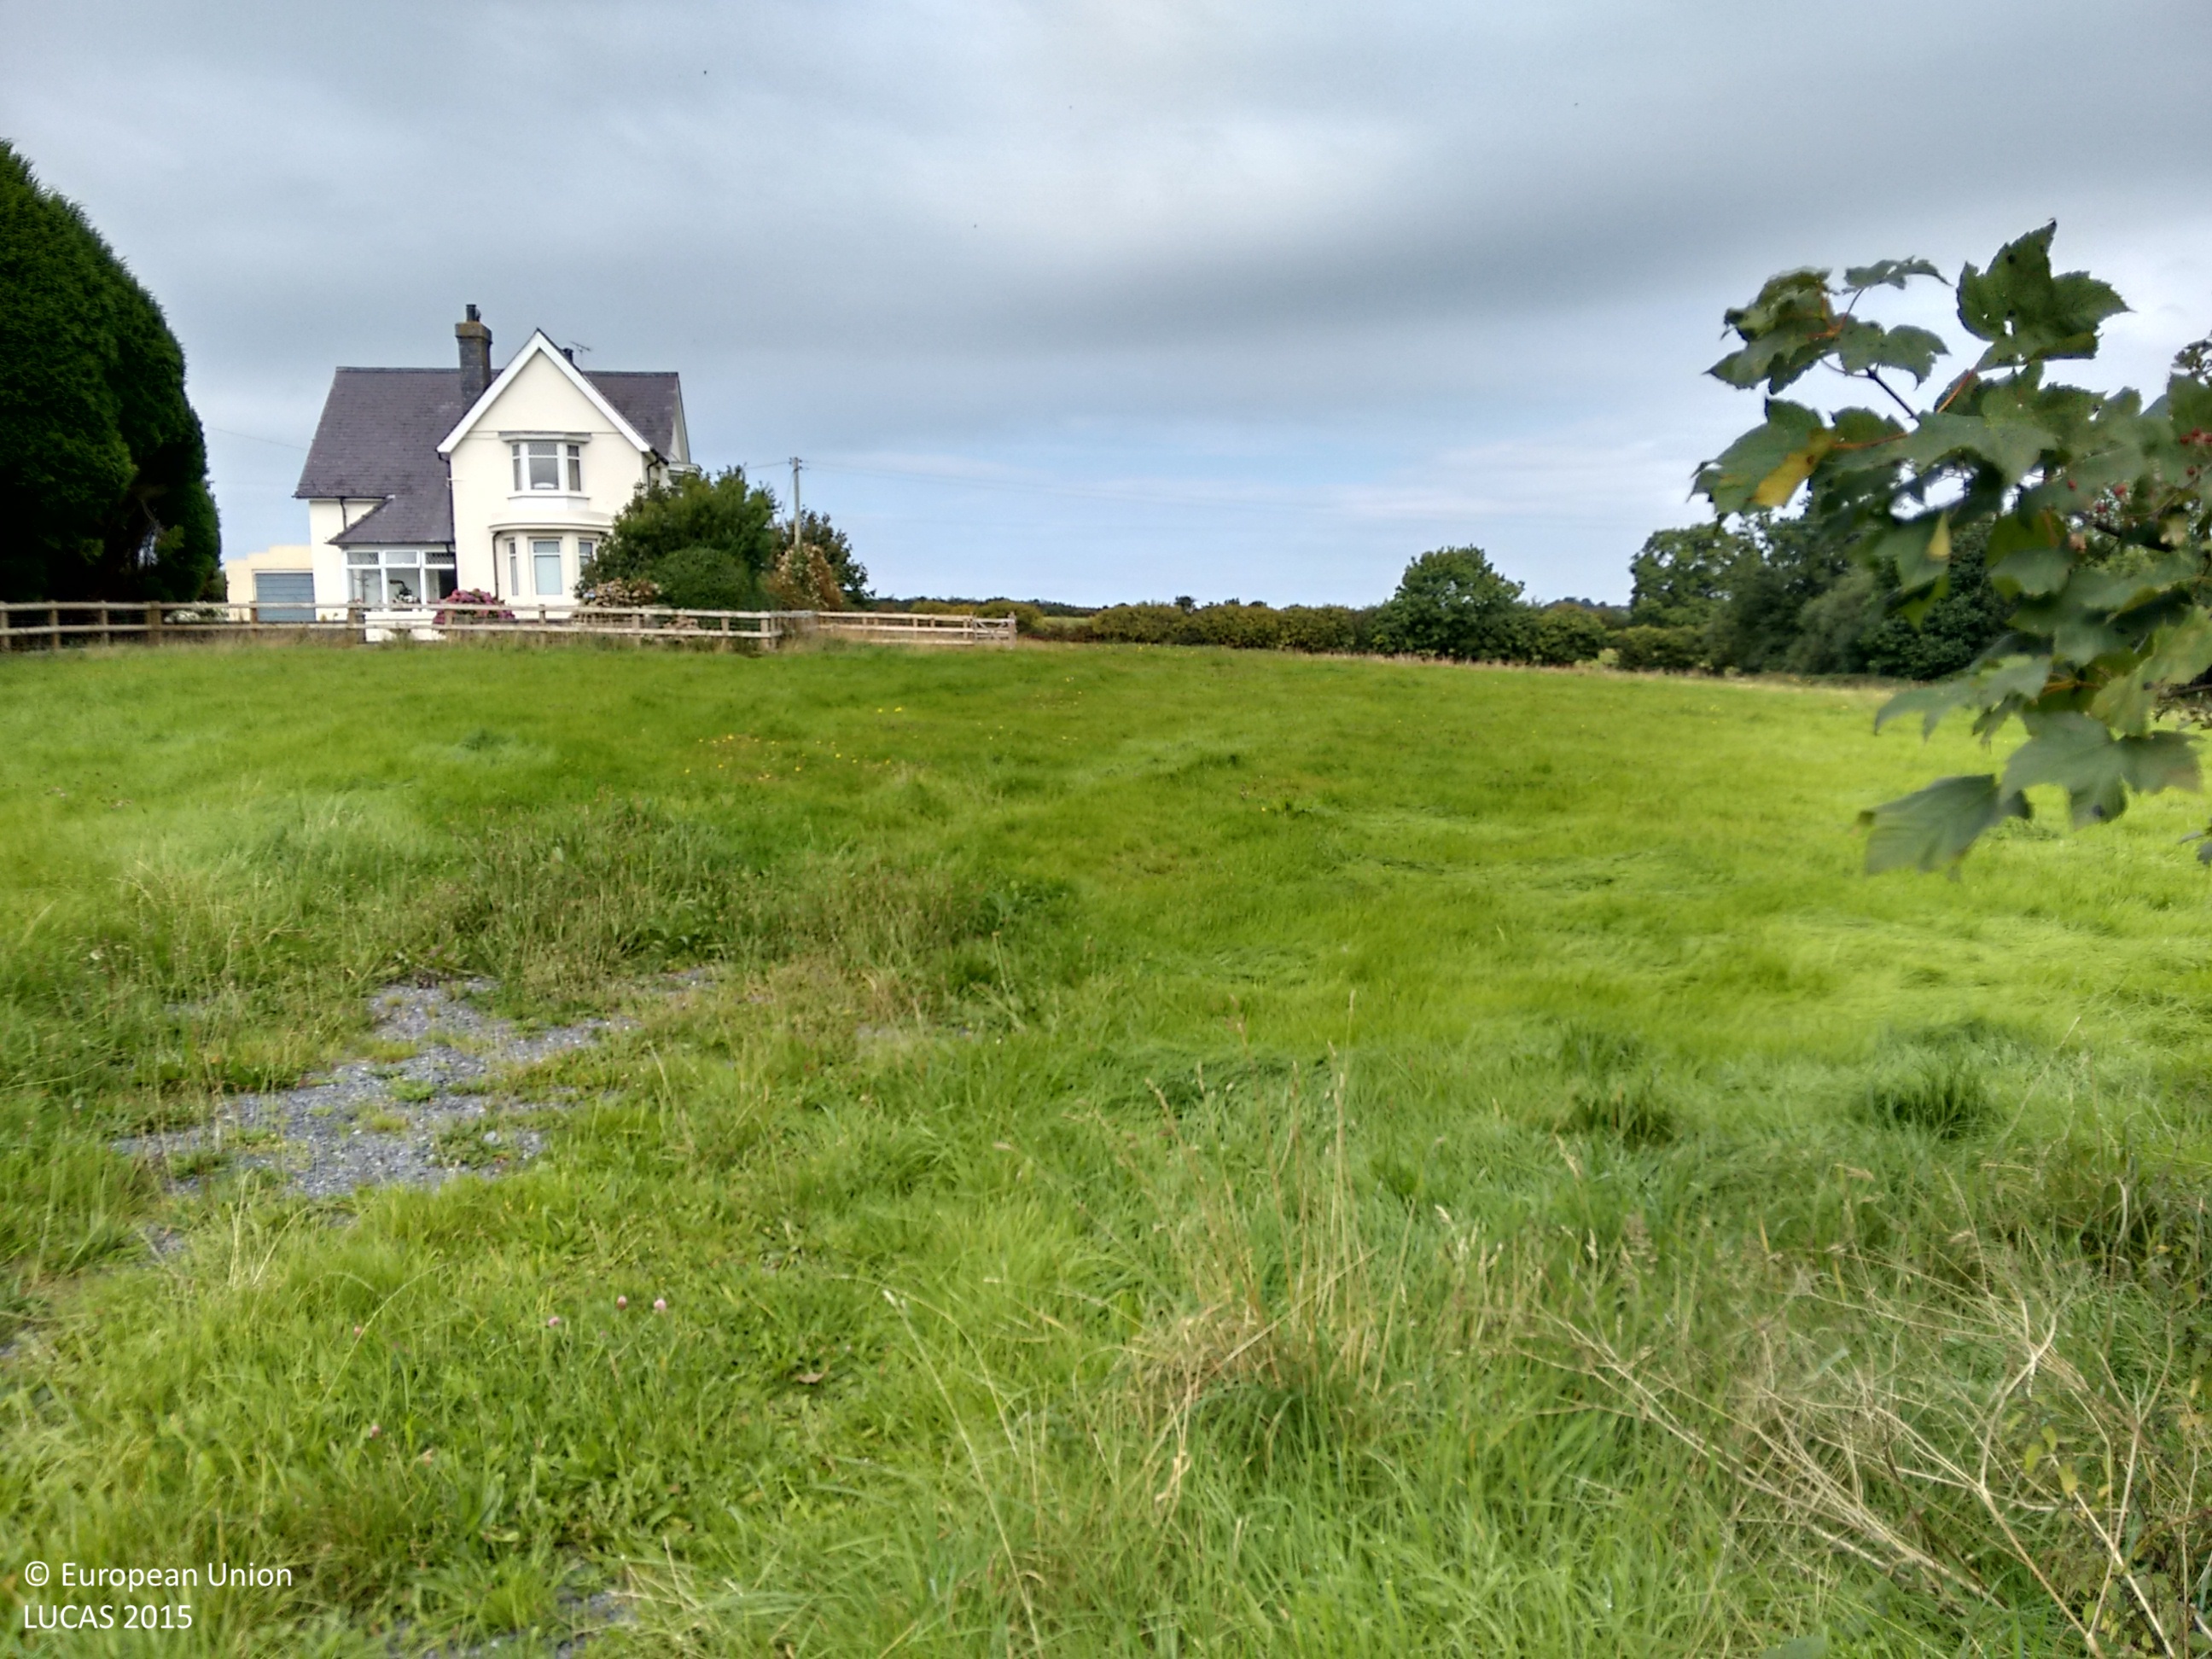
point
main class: Grassland
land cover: Grassland without tree/shrub cover
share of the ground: > 75 %
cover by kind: herbaceous plants 100 %
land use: Agriculture (excluding fallow land and kitchen gardens)
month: September
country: GB
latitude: 52.1108
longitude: -4.5778
